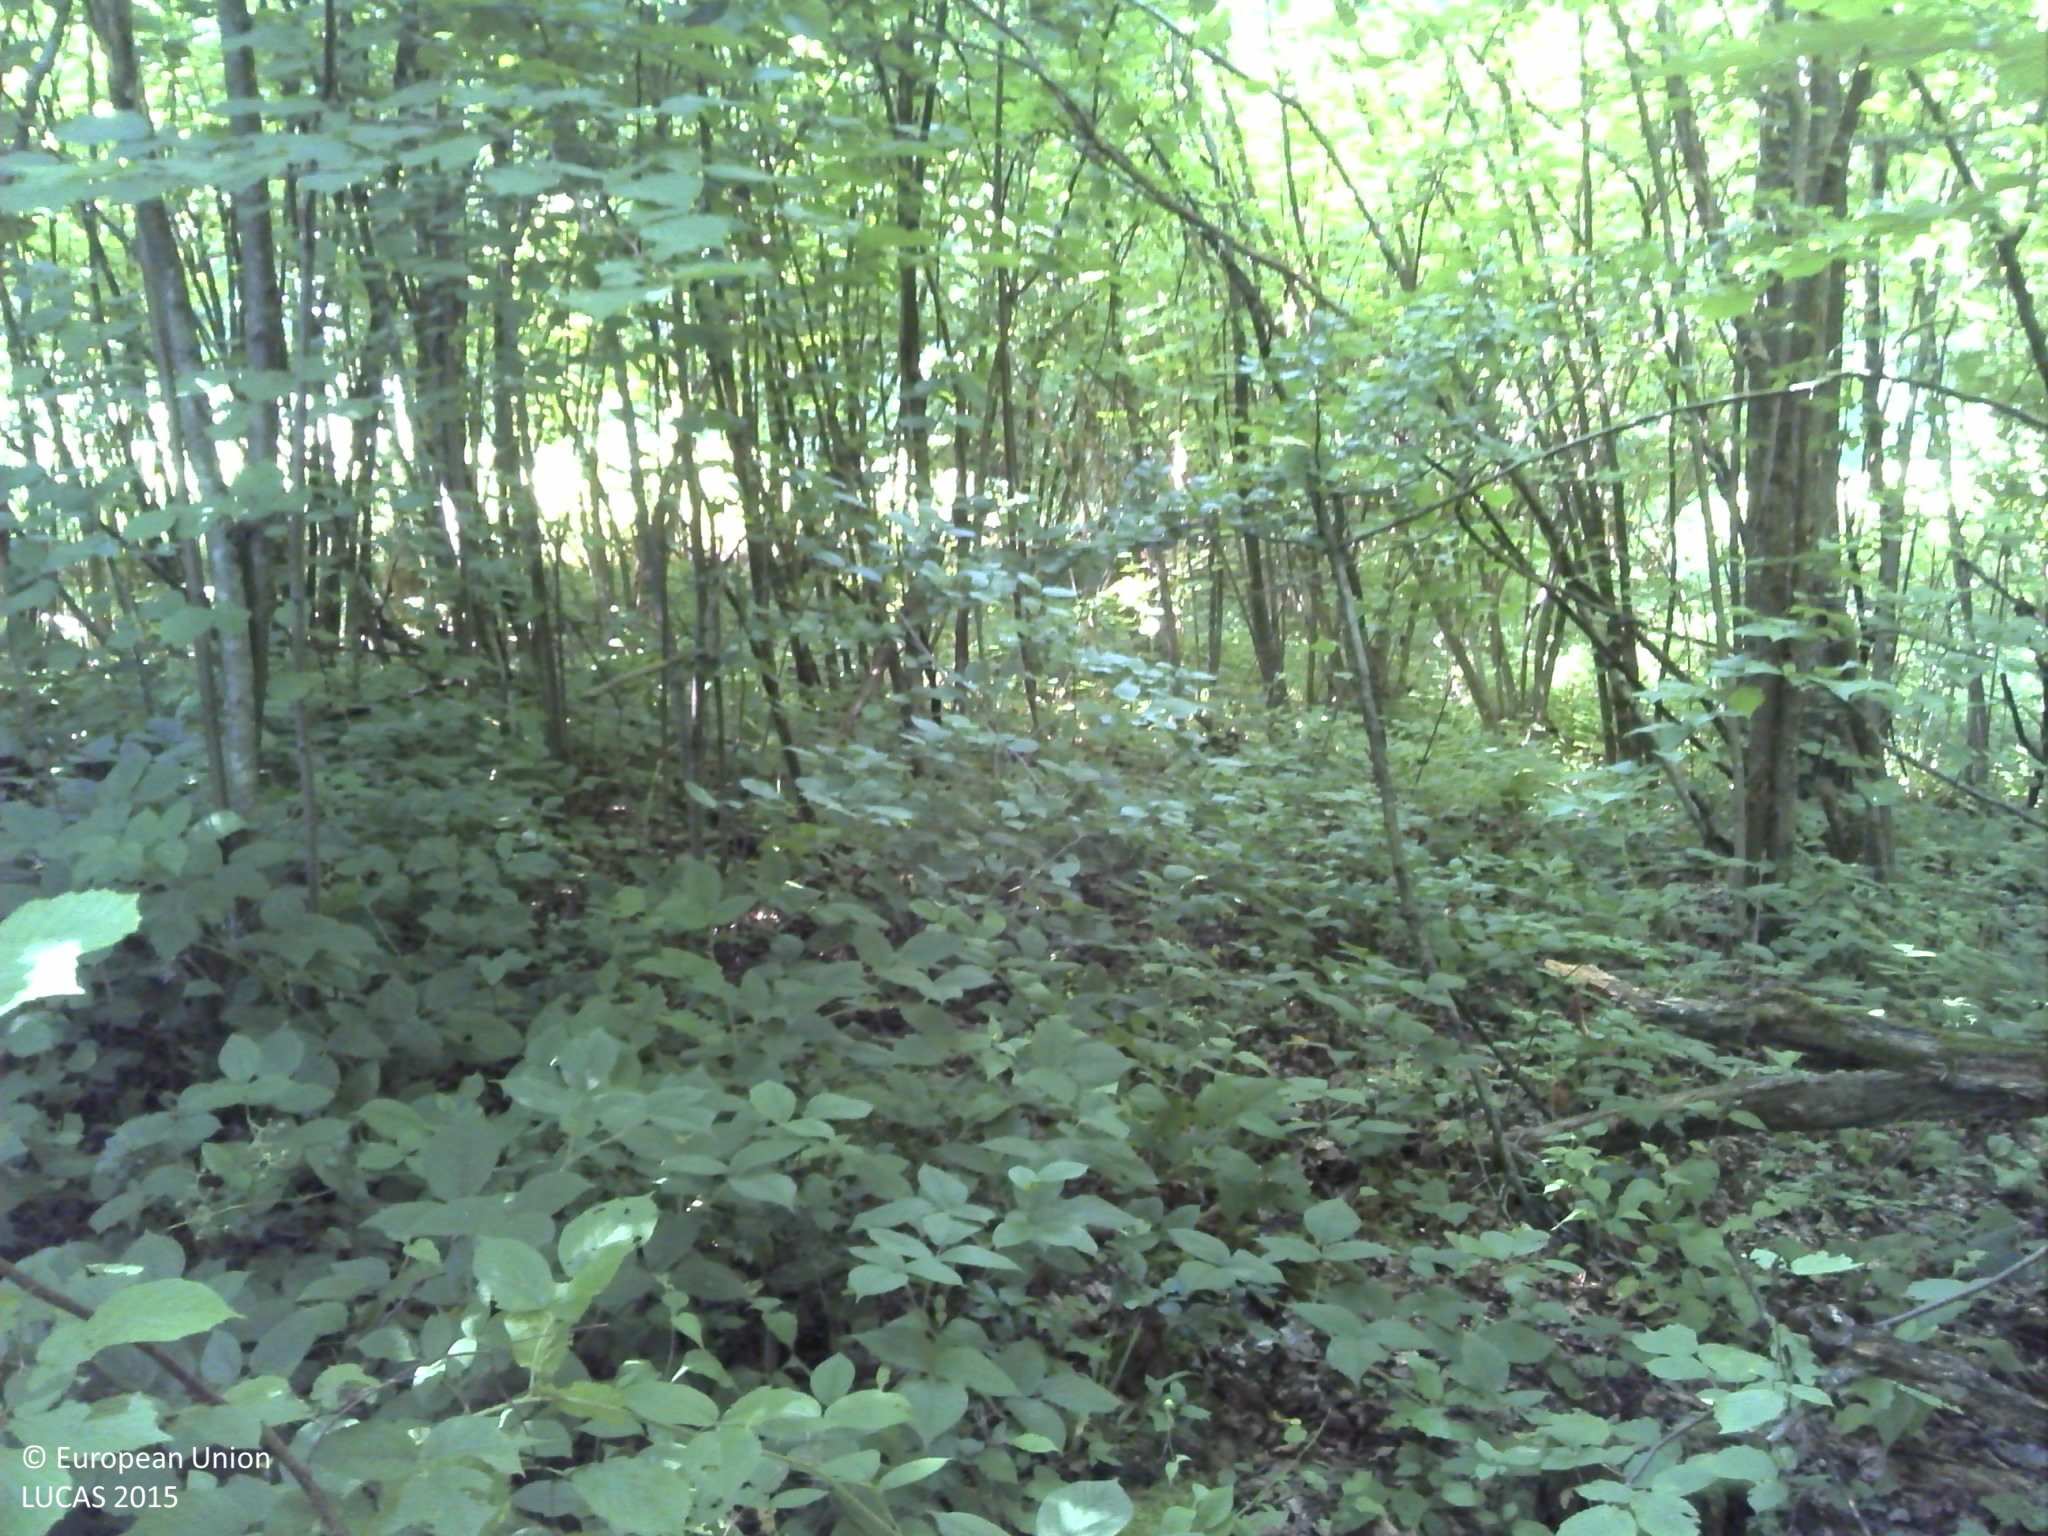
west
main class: Woodland
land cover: Broadleaved woodland
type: acidophilous oak and oak-birch forest
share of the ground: > 75 %
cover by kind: broadleaved forest trees 90 %, shrubs 5 %, herbaceous plants 5 %
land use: Forestry
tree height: > 5 m
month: July
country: HR
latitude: 45.7421
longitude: 16.7216
